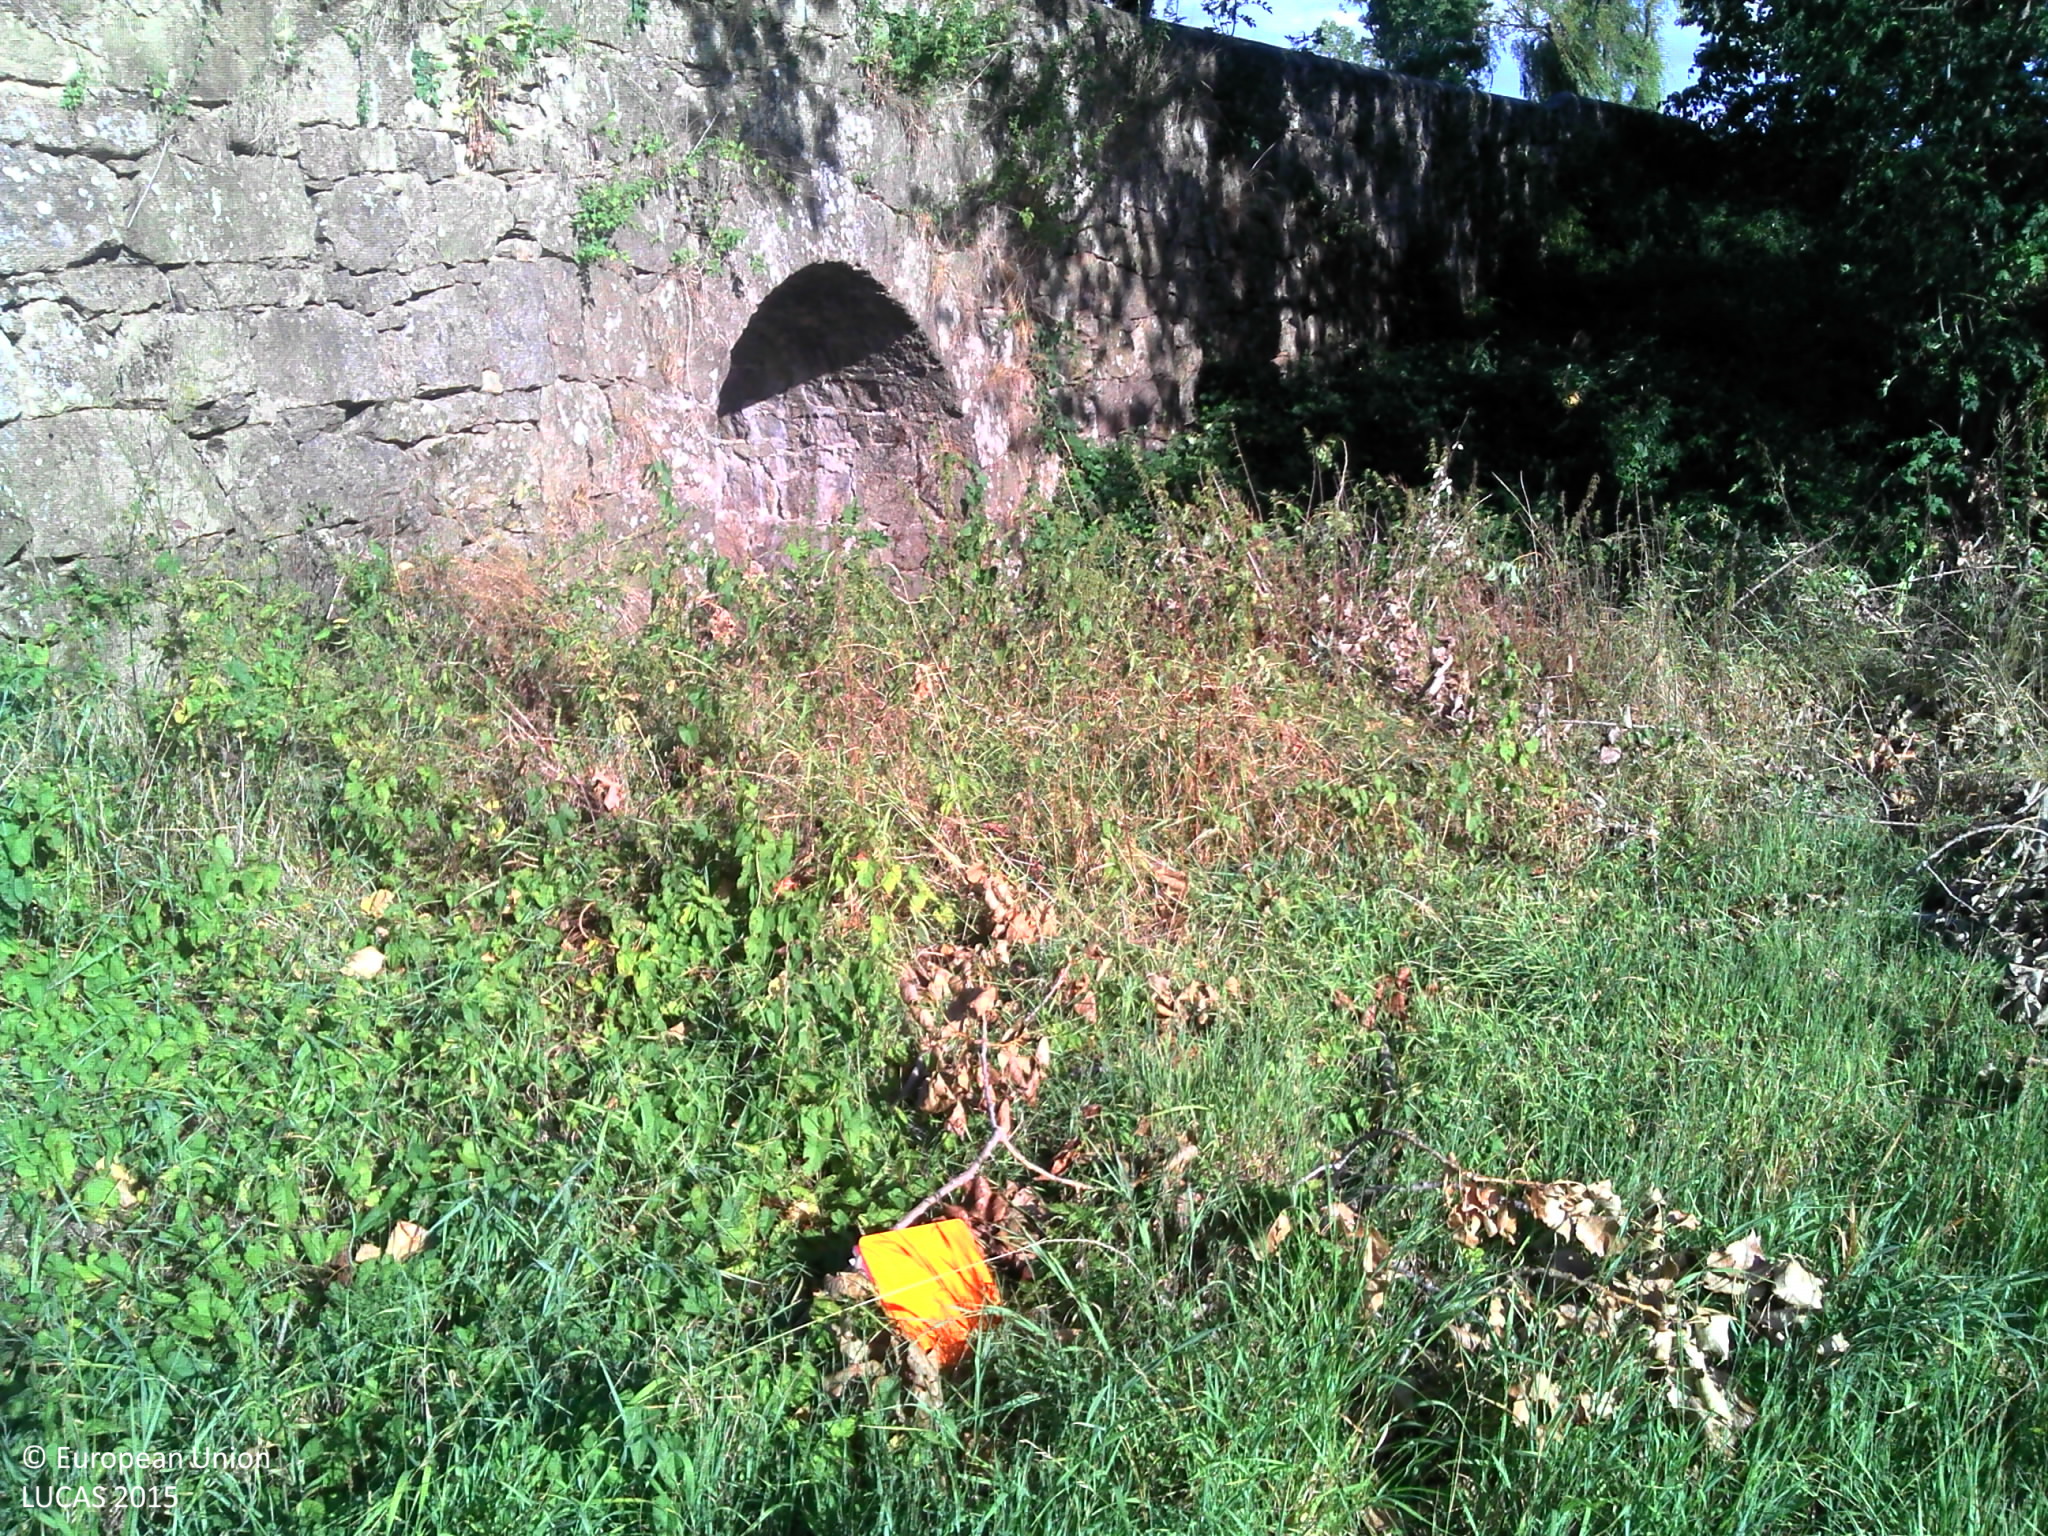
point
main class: Grassland
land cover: Grassland without tree/shrub cover
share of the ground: > 75 %
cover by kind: herbaceous plants 100 %
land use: Agriculture (excluding fallow land and kitchen gardens)
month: August
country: FR
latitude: 45.2804
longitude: 4.6886
